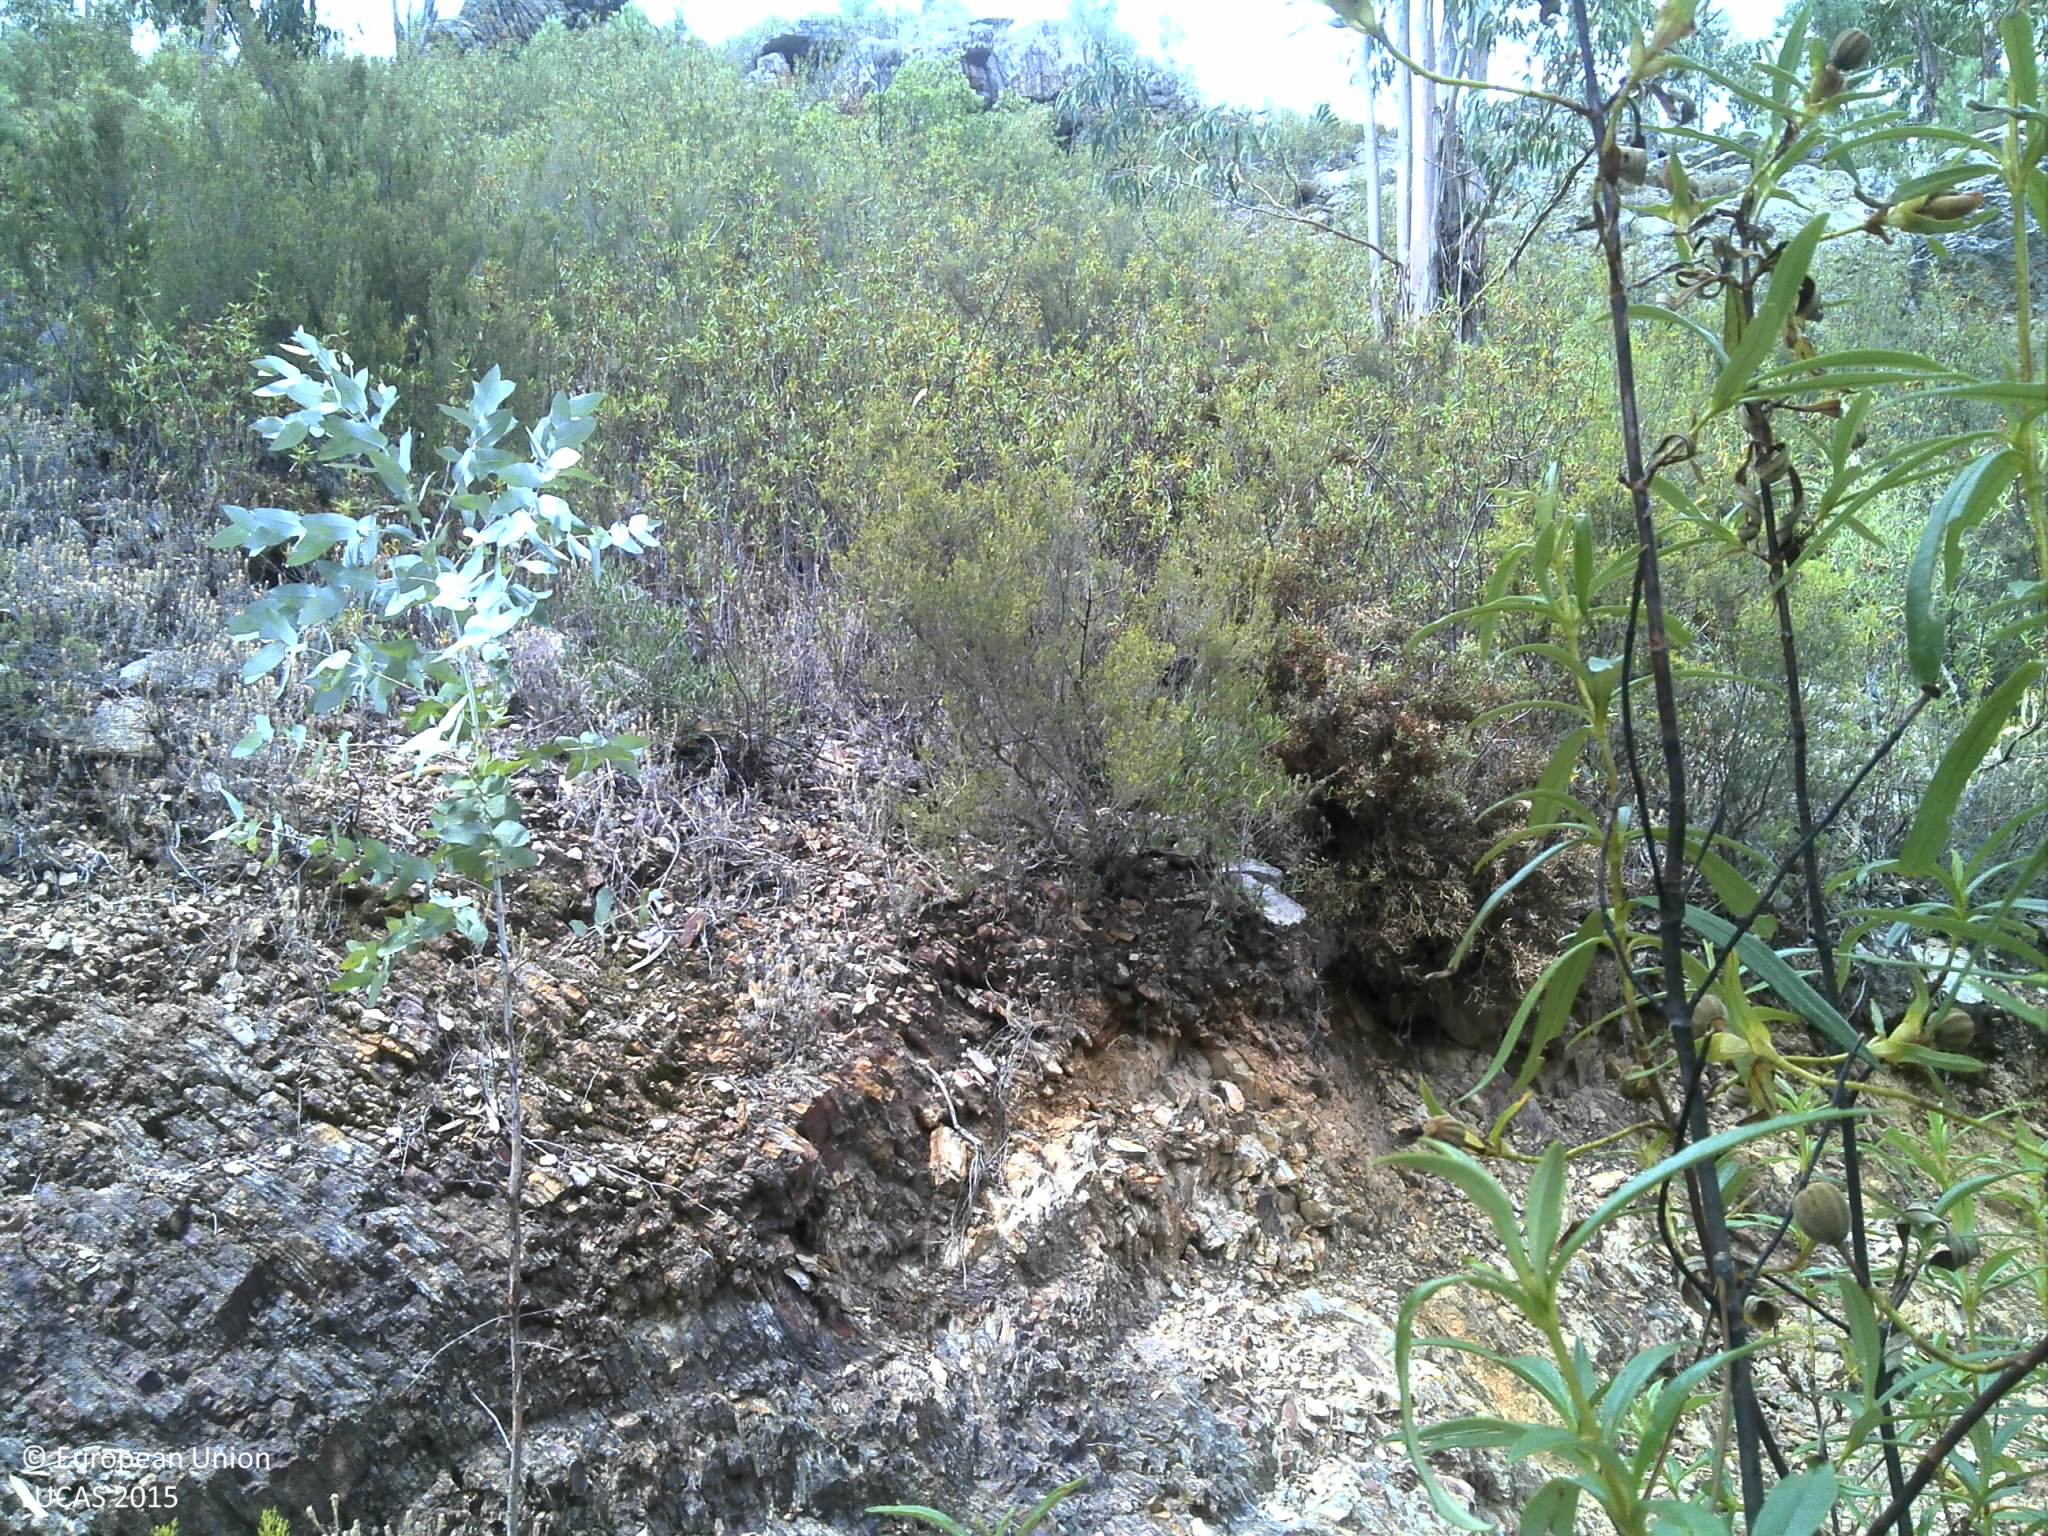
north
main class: Woodland
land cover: Pine dominated mixed woodland
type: coniferous forest of the mediterranean region
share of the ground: 25 - 50 %
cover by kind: shrubs 30 %, unconsolidated bare surface 25 %, consolidated bare surface 20 %, broadleaved forest trees 15 %, coniferous forest trees 10 %
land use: Forestry
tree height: > 5 m
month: July
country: PT
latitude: 39.6153
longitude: -8.0354
